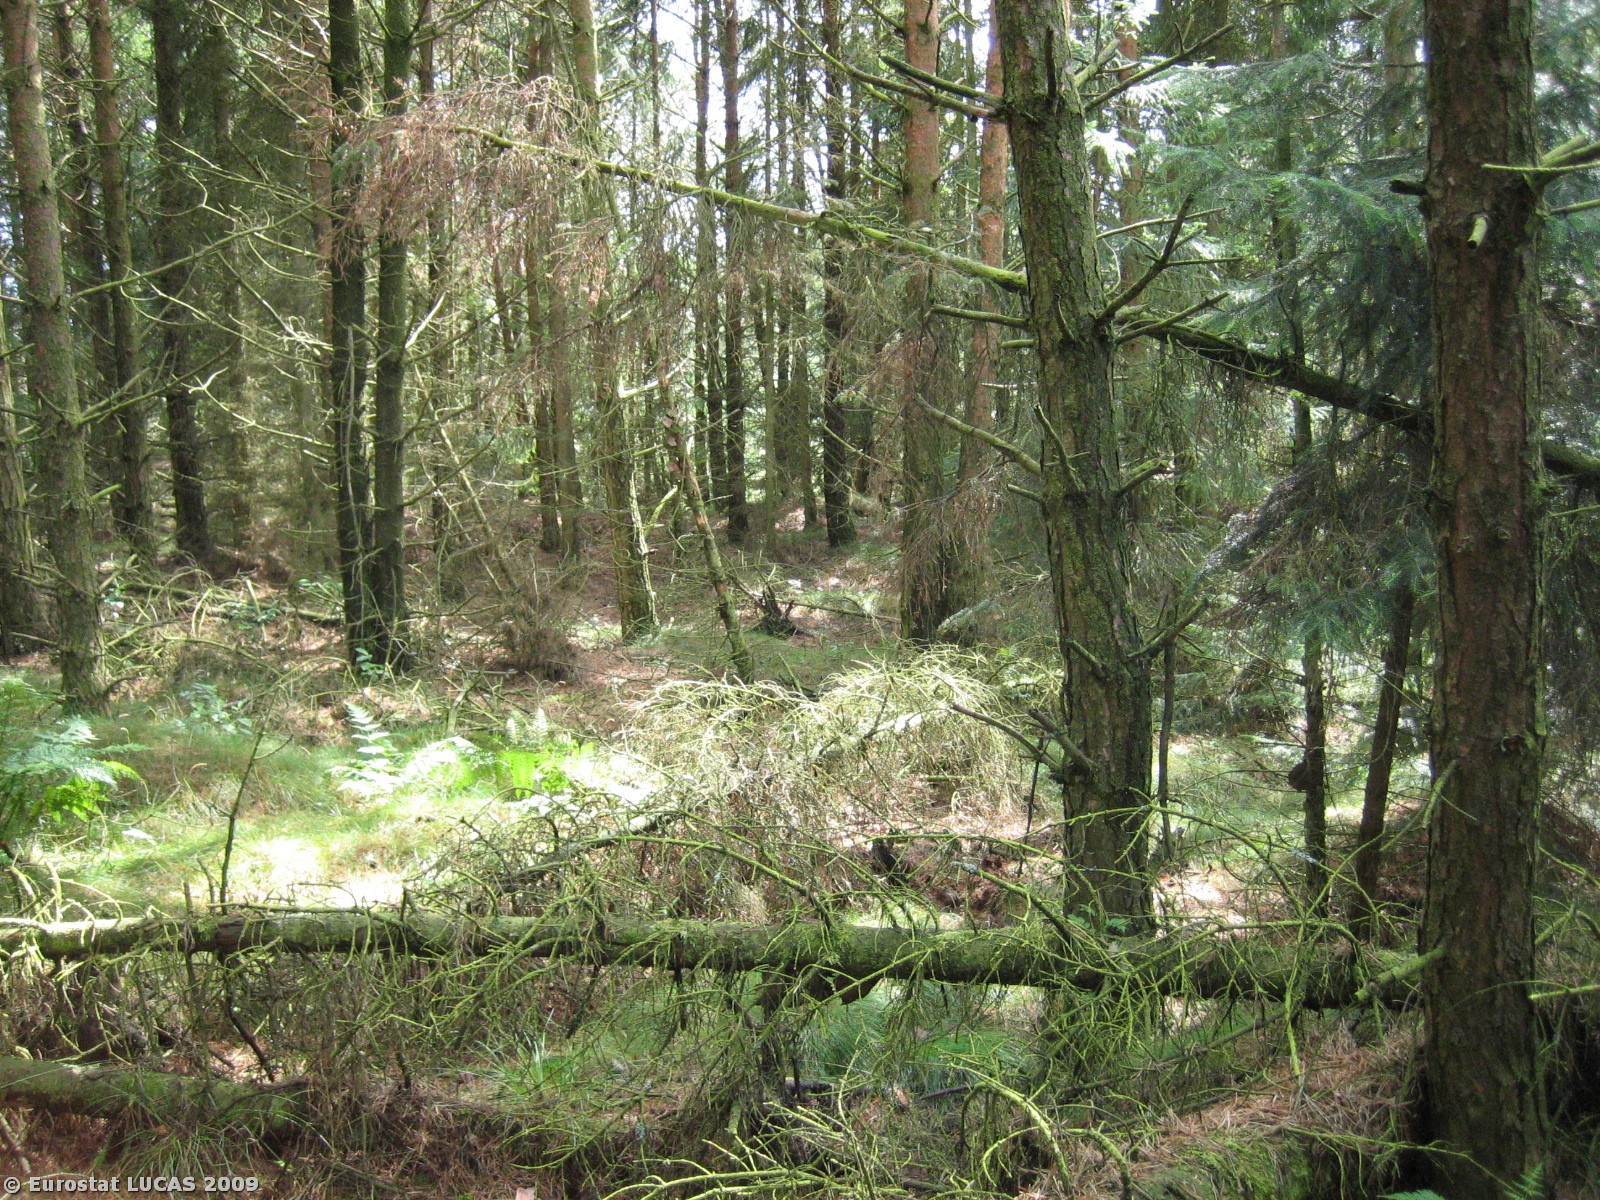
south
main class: Woodland
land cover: Coniferous woodland
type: hemiboreal forest and nemoral coniferous forest and mixed broadleaved-coniferous forest
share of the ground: > 75 %
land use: Forestry
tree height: > 5 m
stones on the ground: < 10 %
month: July
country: DK
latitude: 55.6786
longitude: 8.7767
